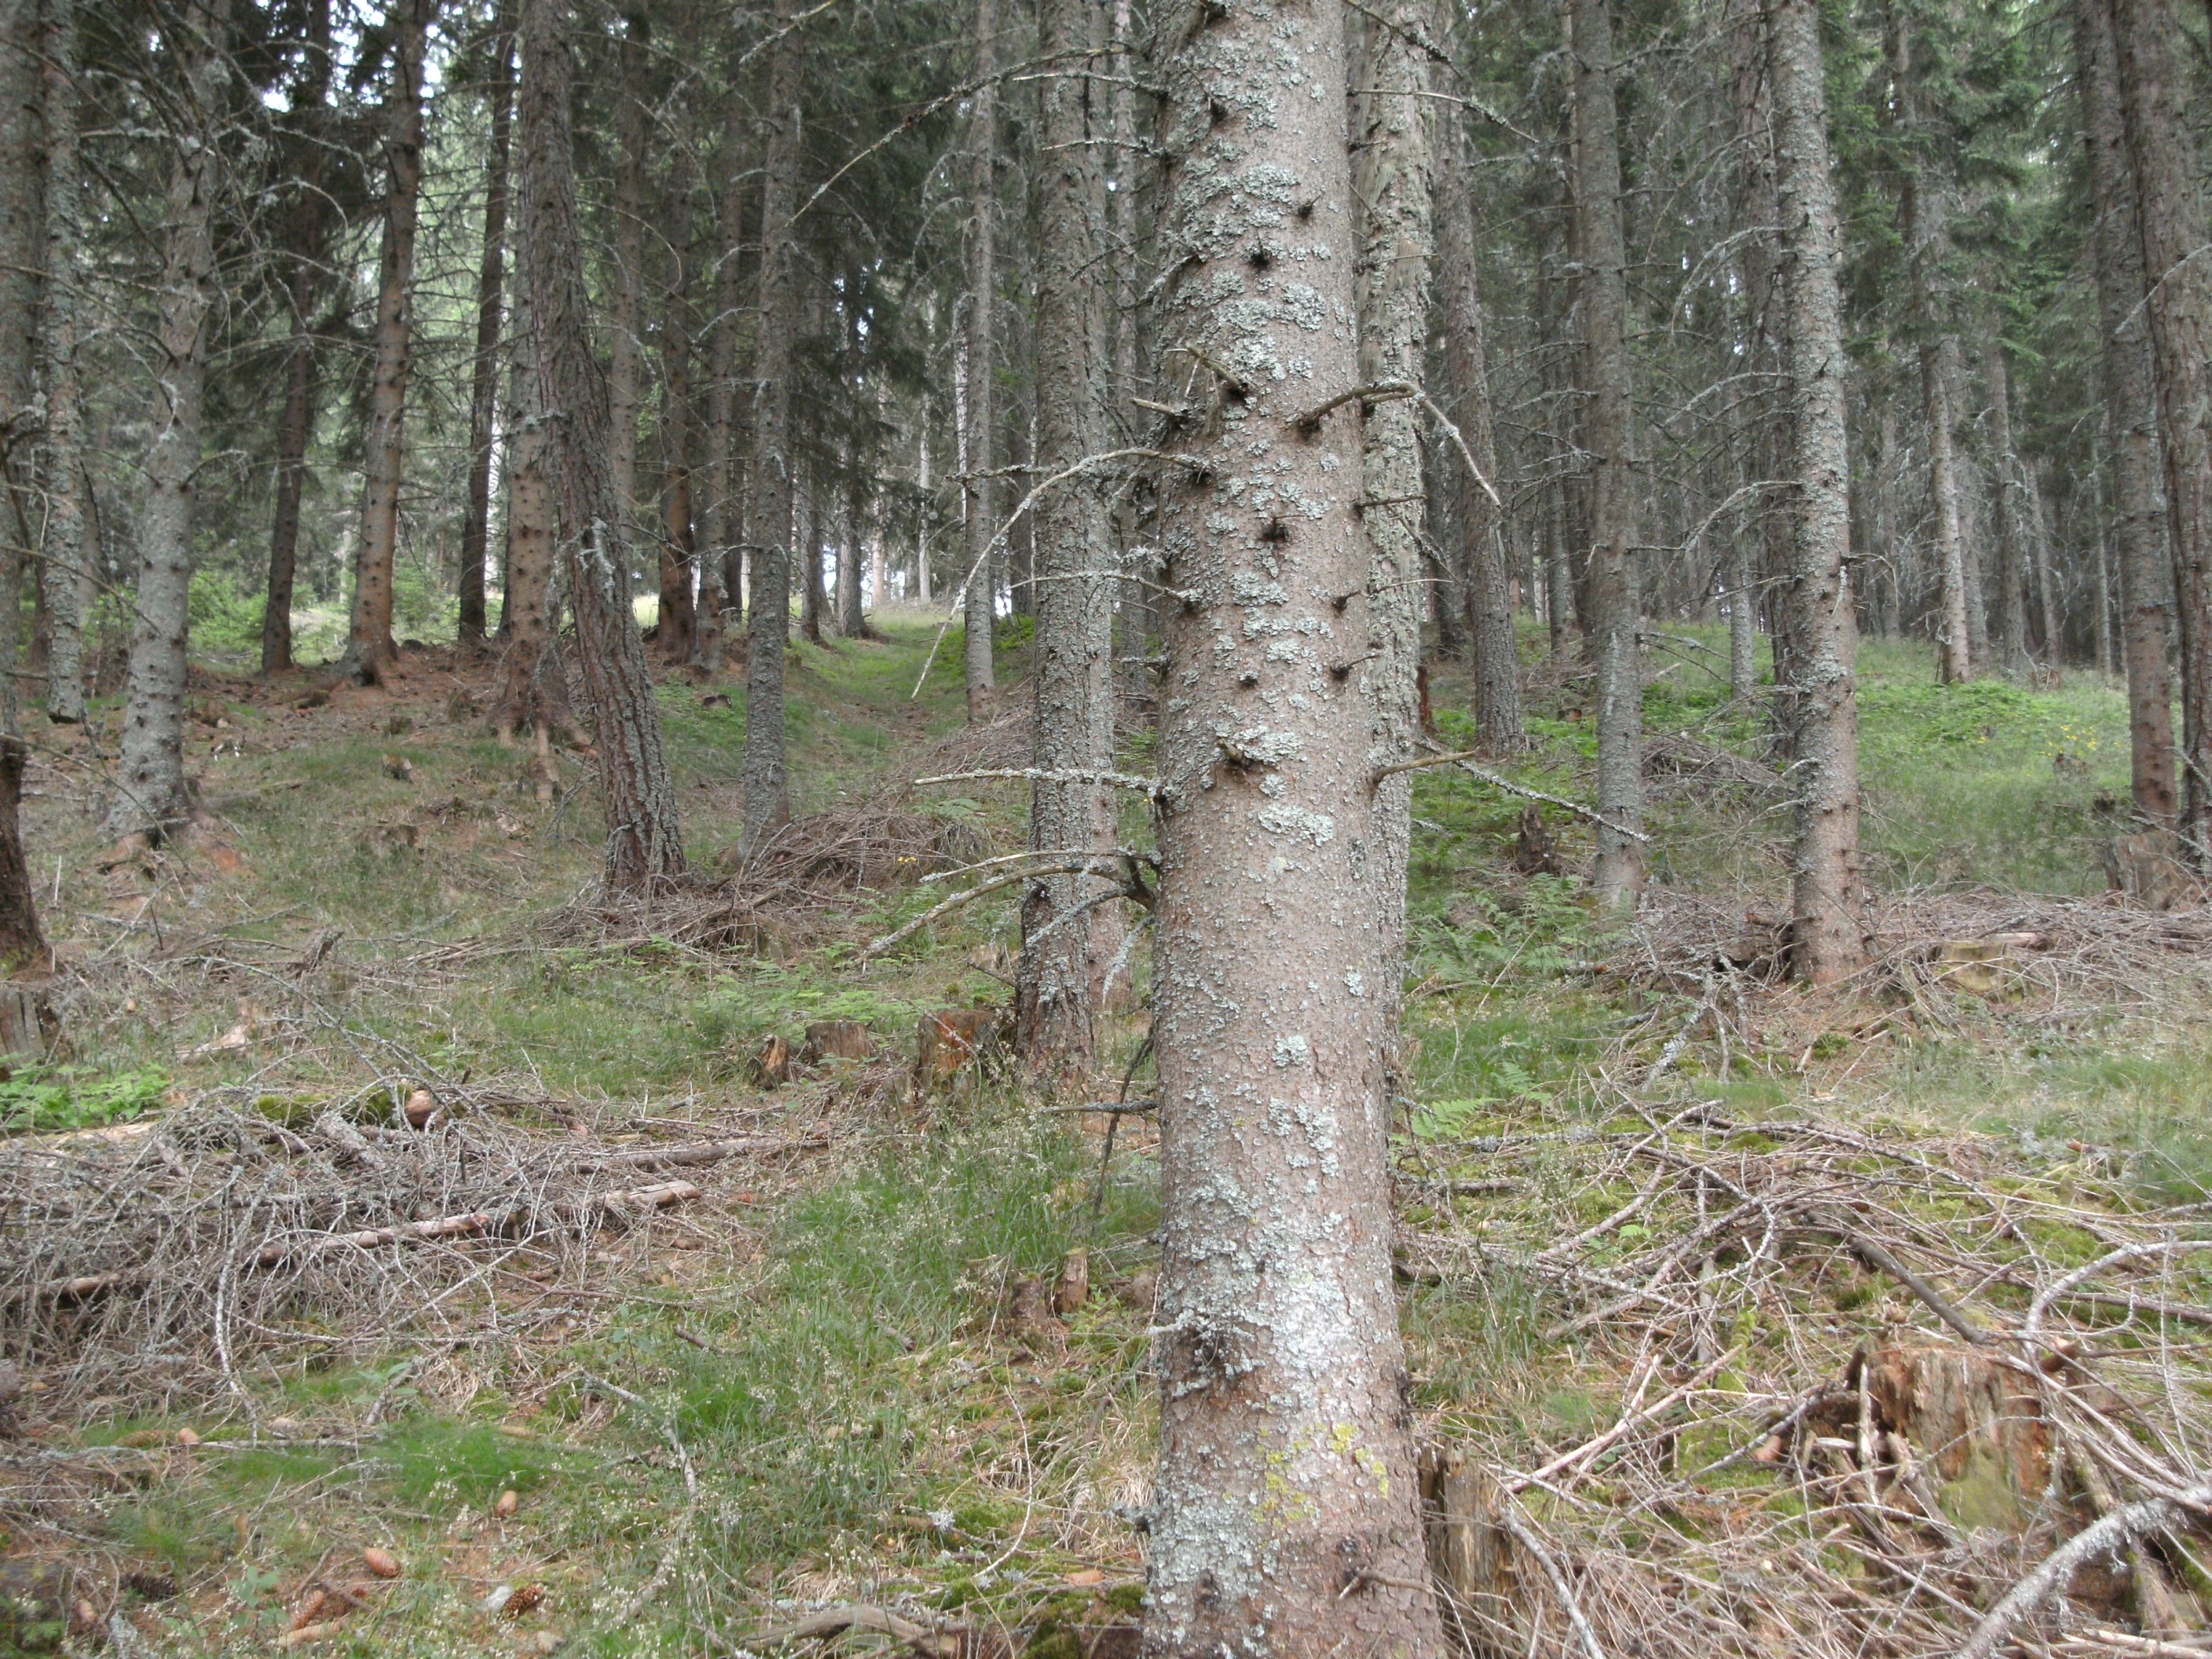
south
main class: Woodland
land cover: Other coniferous woodland
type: alpine coniferous forest
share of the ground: 50 - 75 %
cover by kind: coniferous forest trees 75 %, shrubs 20 %, unconsolidated bare surface 5 %
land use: Forestry
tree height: > 5 m
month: July
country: AT
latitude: 46.9676
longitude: 14.7432
